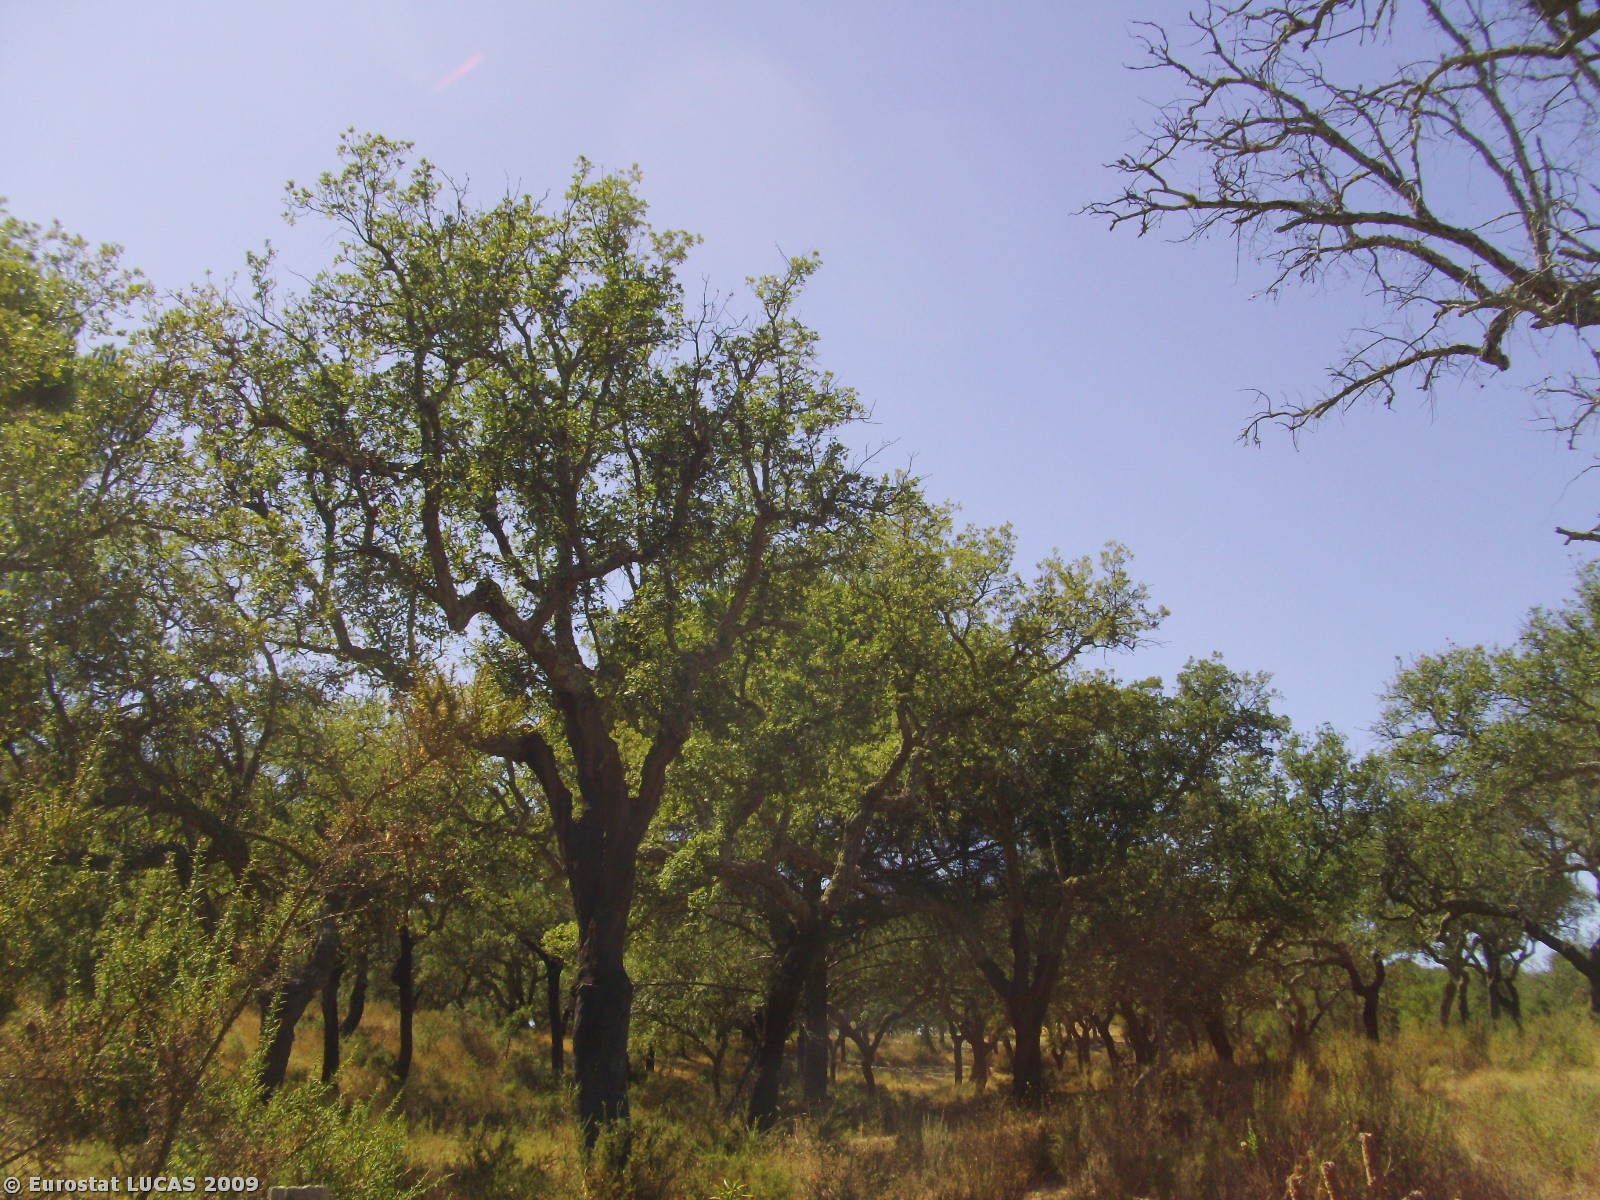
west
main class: Woodland
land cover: Broadleaved woodland
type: broadleaved evergreen forest
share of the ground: 50 - 75 %
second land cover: Spontaneously vegetated surfaces
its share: 50 - 75 %
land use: Forestry
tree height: > 5 m
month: July
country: PT
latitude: 38.3151
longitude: -8.4505
